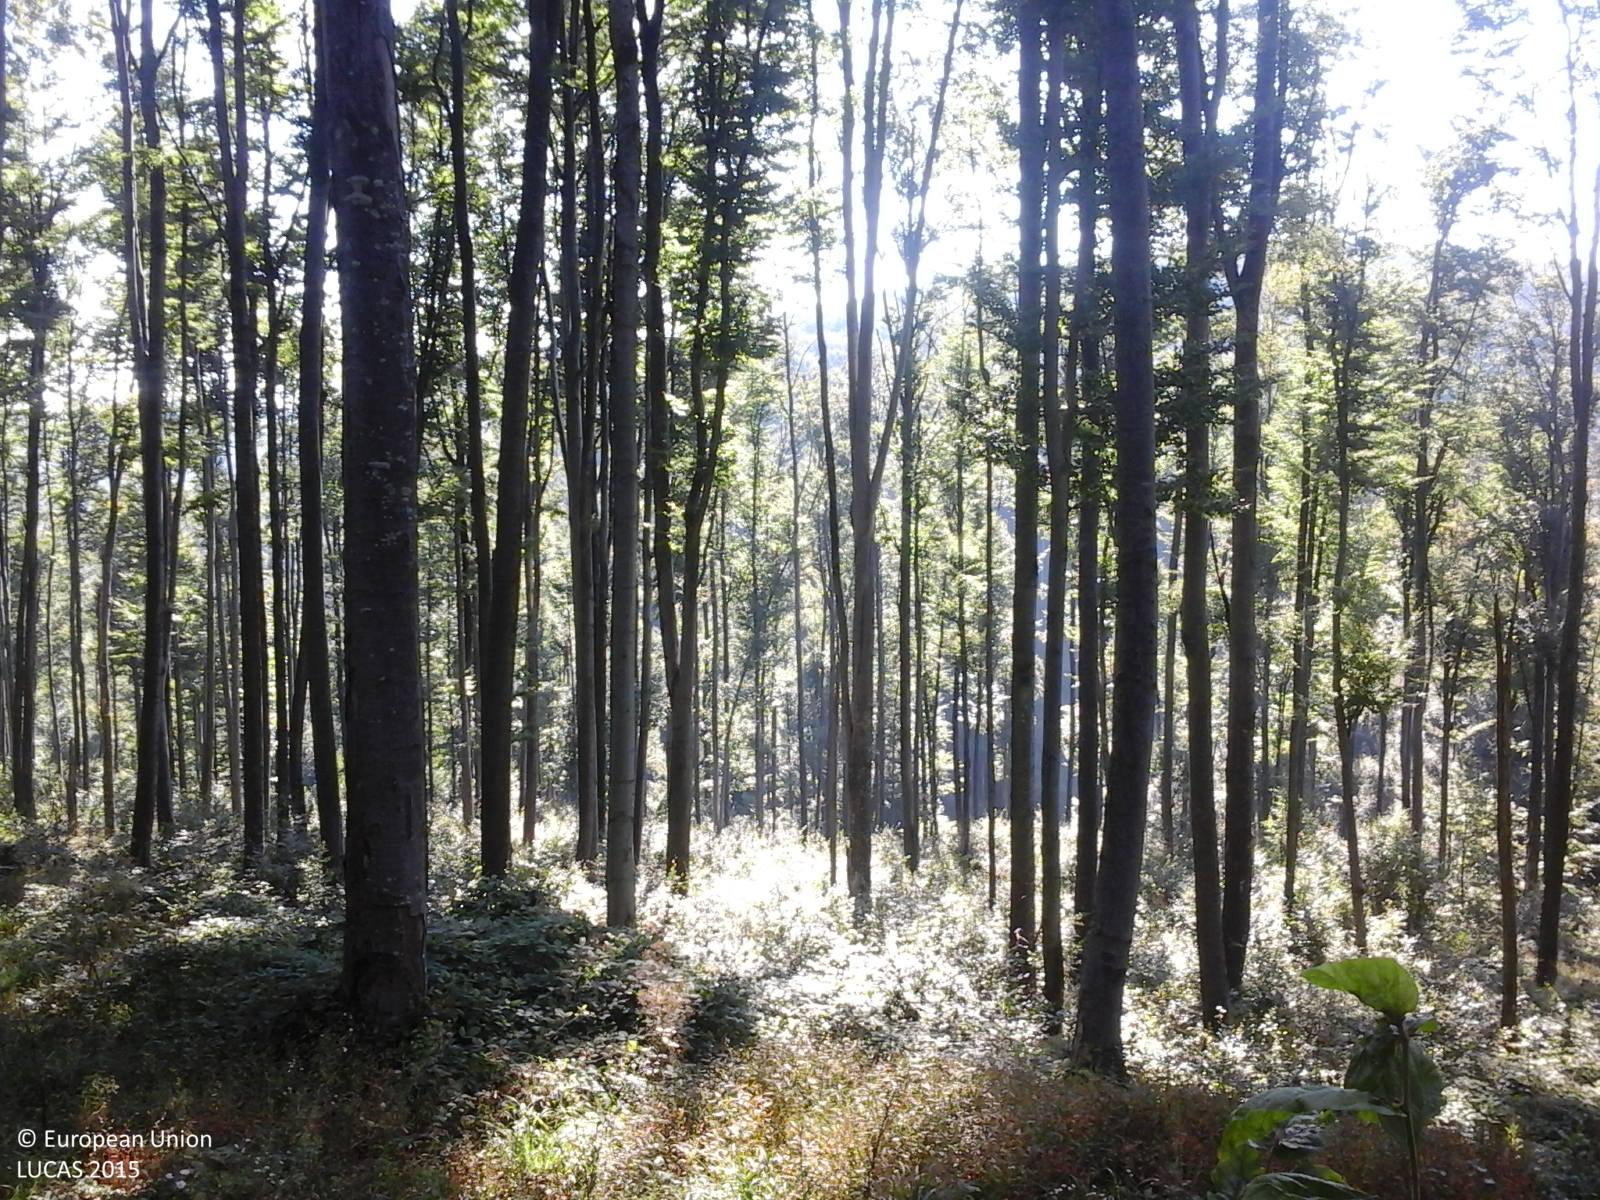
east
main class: Woodland
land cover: Broadleaved woodland
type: beech forest
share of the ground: > 75 %
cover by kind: broadleaved forest trees 100 %
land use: Forestry
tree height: > 5 m
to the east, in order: Broadleaved woodland
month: September
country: RO
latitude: 47.1310
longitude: 22.4599
